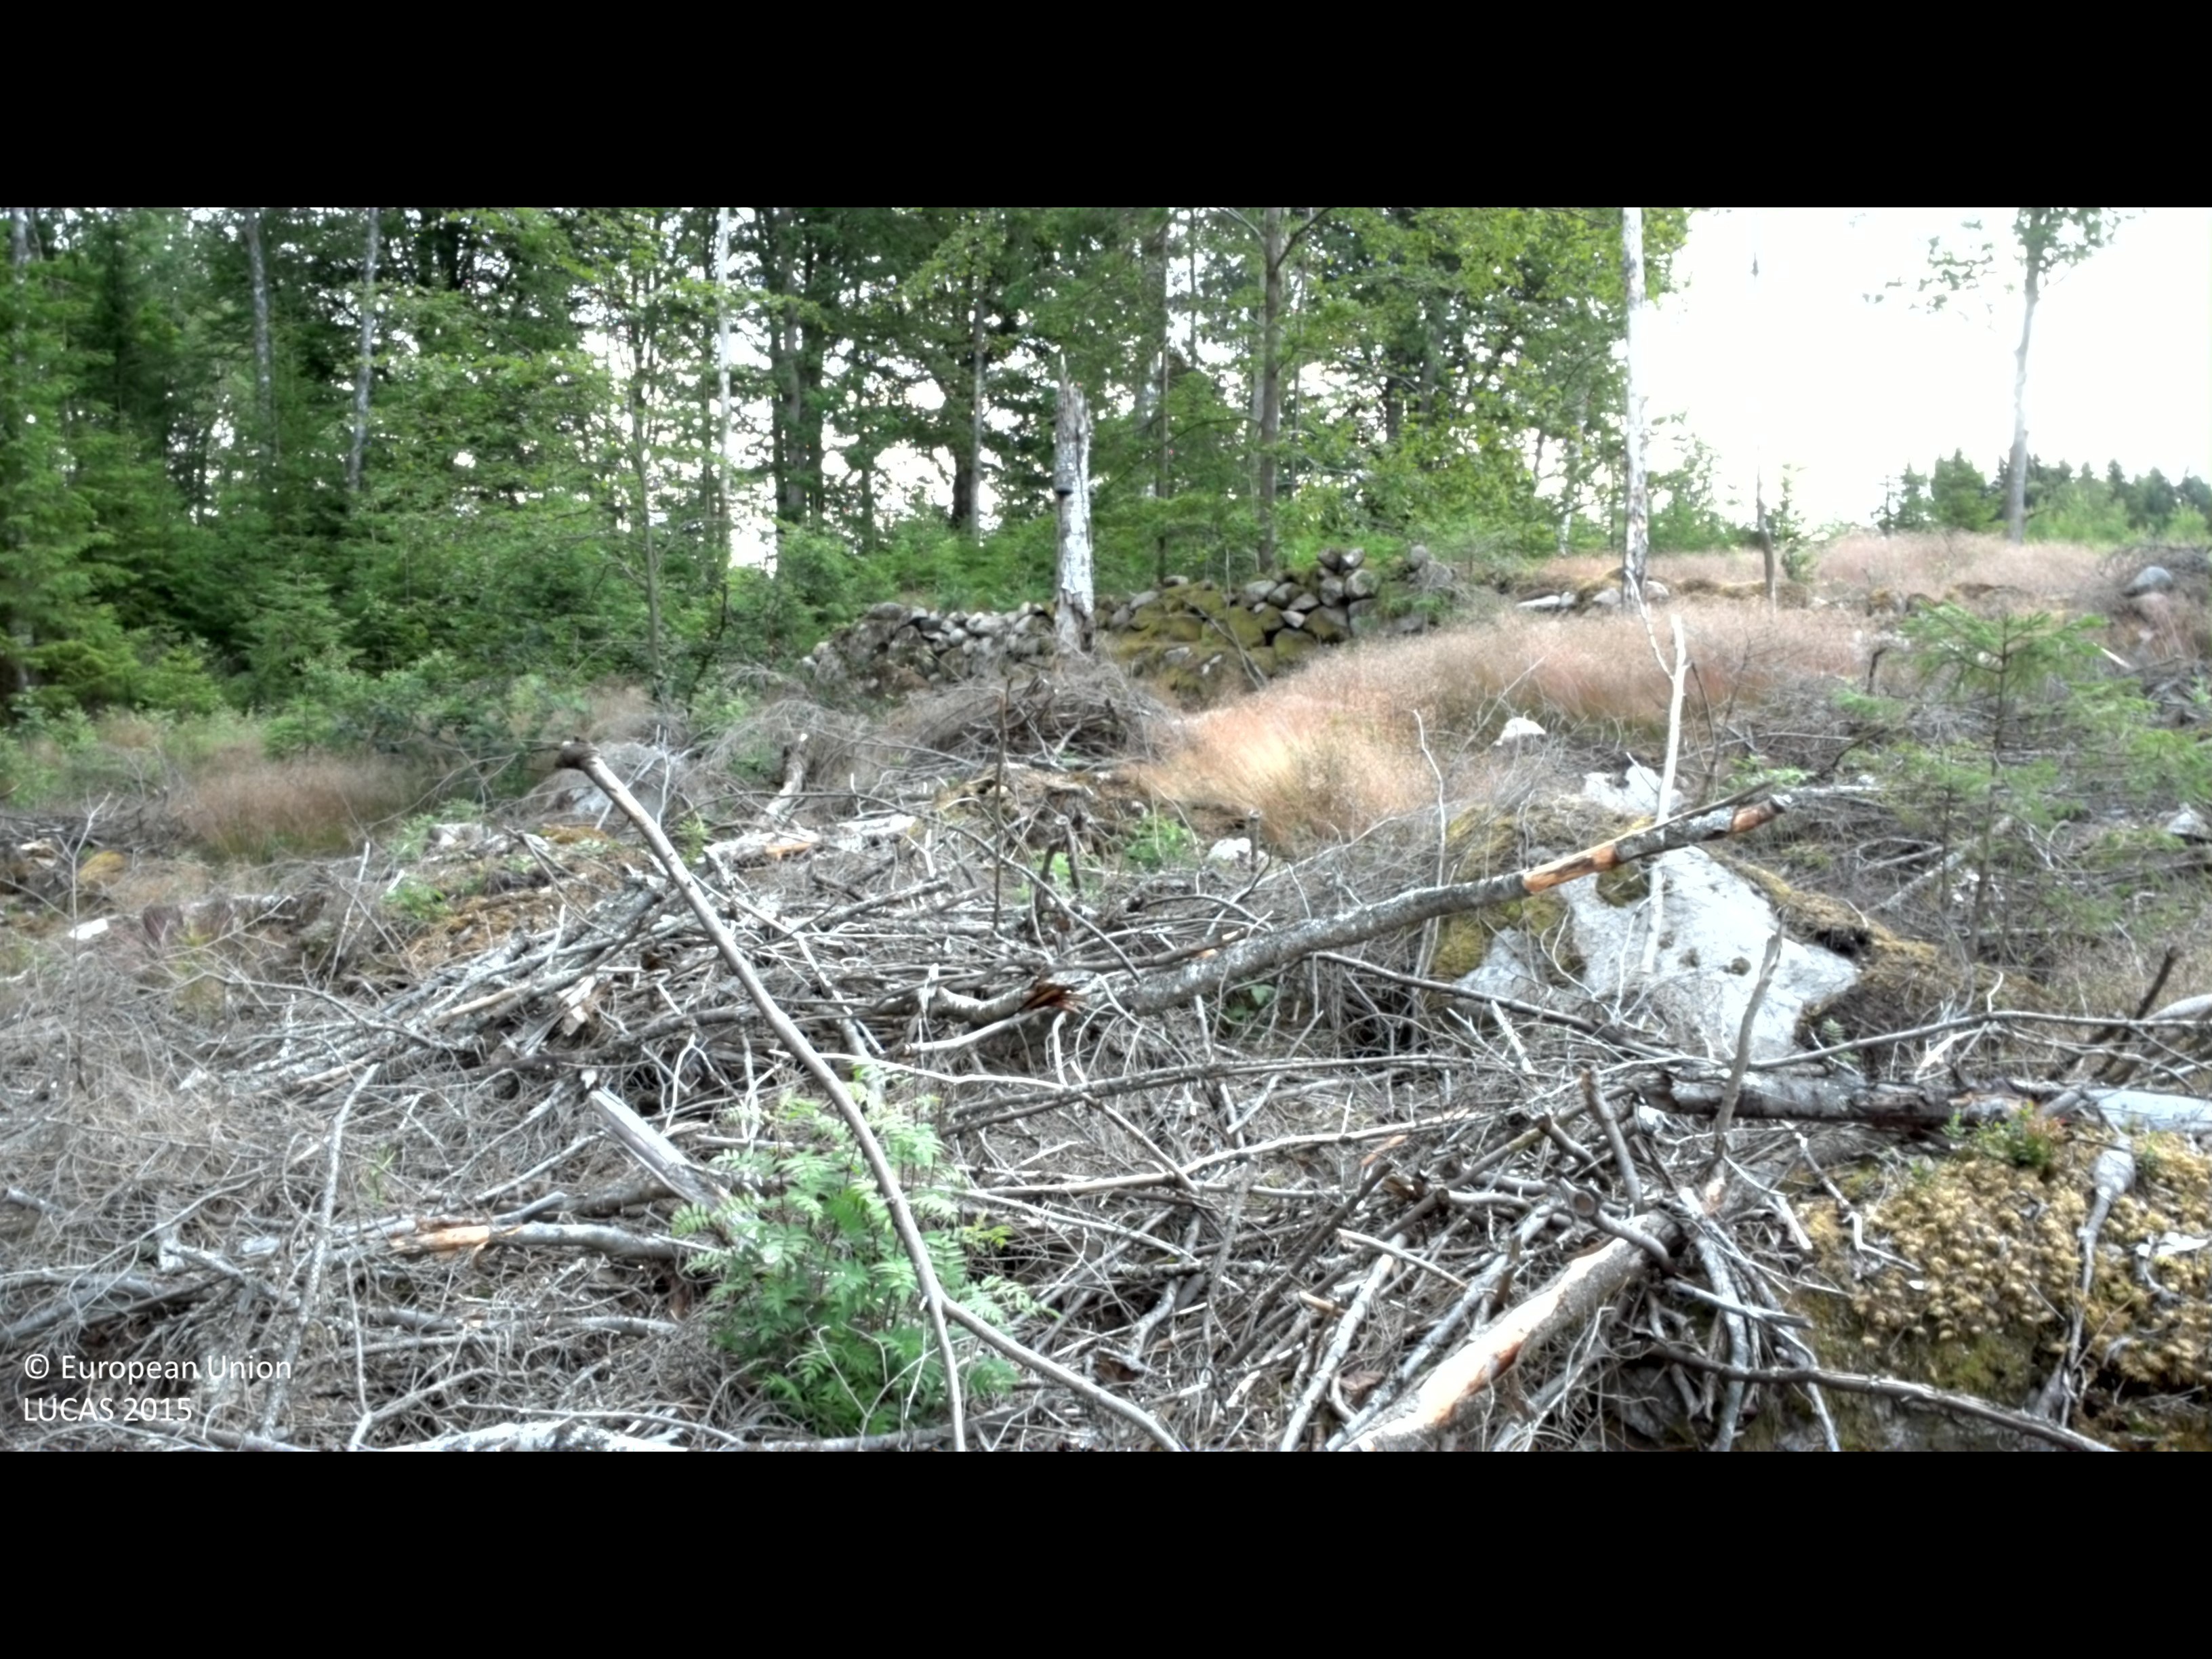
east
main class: Woodland
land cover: Spruce dominated mixed woodland
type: boreal forest
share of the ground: 10 - 25 %
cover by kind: shrubs 20 %, coniferous forest trees 15 %, herbaceous plants 15 %, unconsolidated bare surface 10 %, broadleaved forest trees 5 %, lichens and mosses 5 %
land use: Forestry
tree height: > 5 m
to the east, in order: Spruce dominated mixed woodland; Dry stone walls; Spruce dominated mixed woodland; Broadleaved woodland; Fences; Grassland without tree/shrub cover; Fences; Grass margins; Paved roads, cycling and walking lanes; Grass margins; Artificial constructions in urban areas; Fences; Grassland without tree/shrub cover; Fences; Broadleaved woodland; Rock outcrops
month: July
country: SE
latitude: 56.4453
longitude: 14.1339
